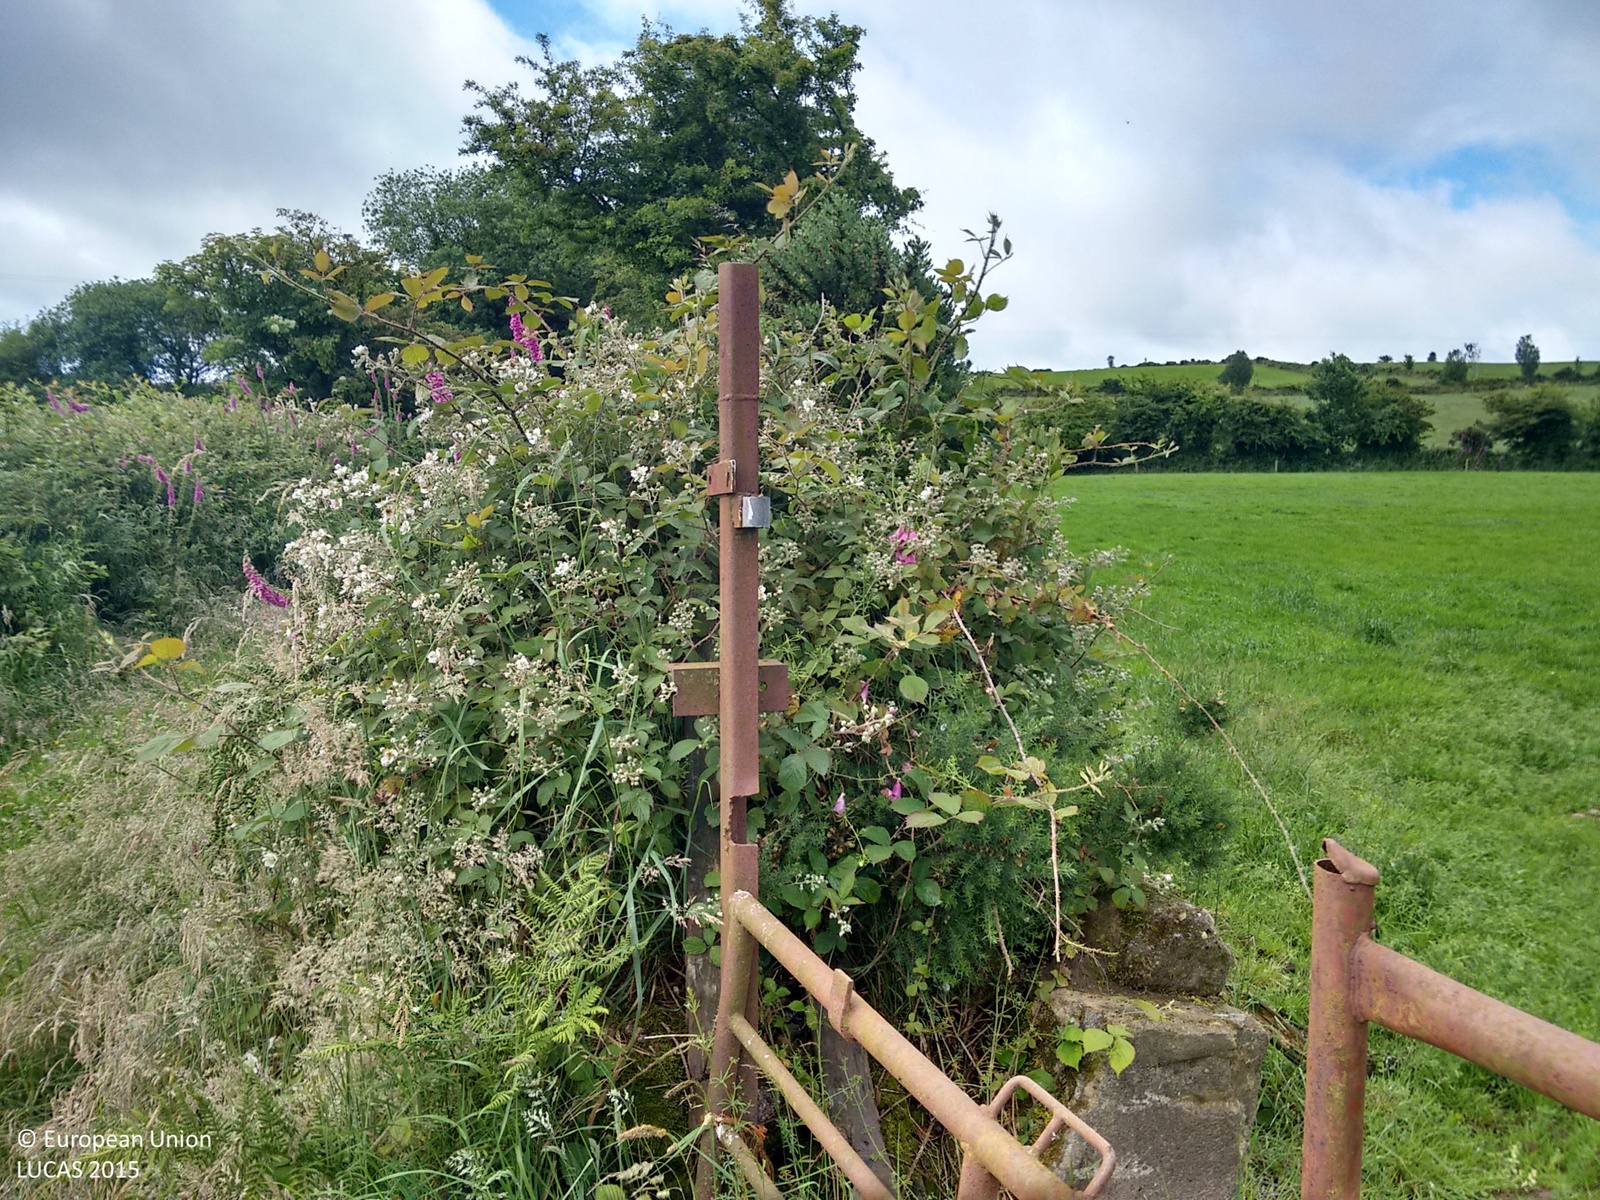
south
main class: Grassland
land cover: Grassland without tree/shrub cover
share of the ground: > 75 %
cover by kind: herbaceous plants 100 %
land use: Agriculture (excluding fallow land and kitchen gardens)
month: July
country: IE
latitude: 52.2475
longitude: -8.1836
